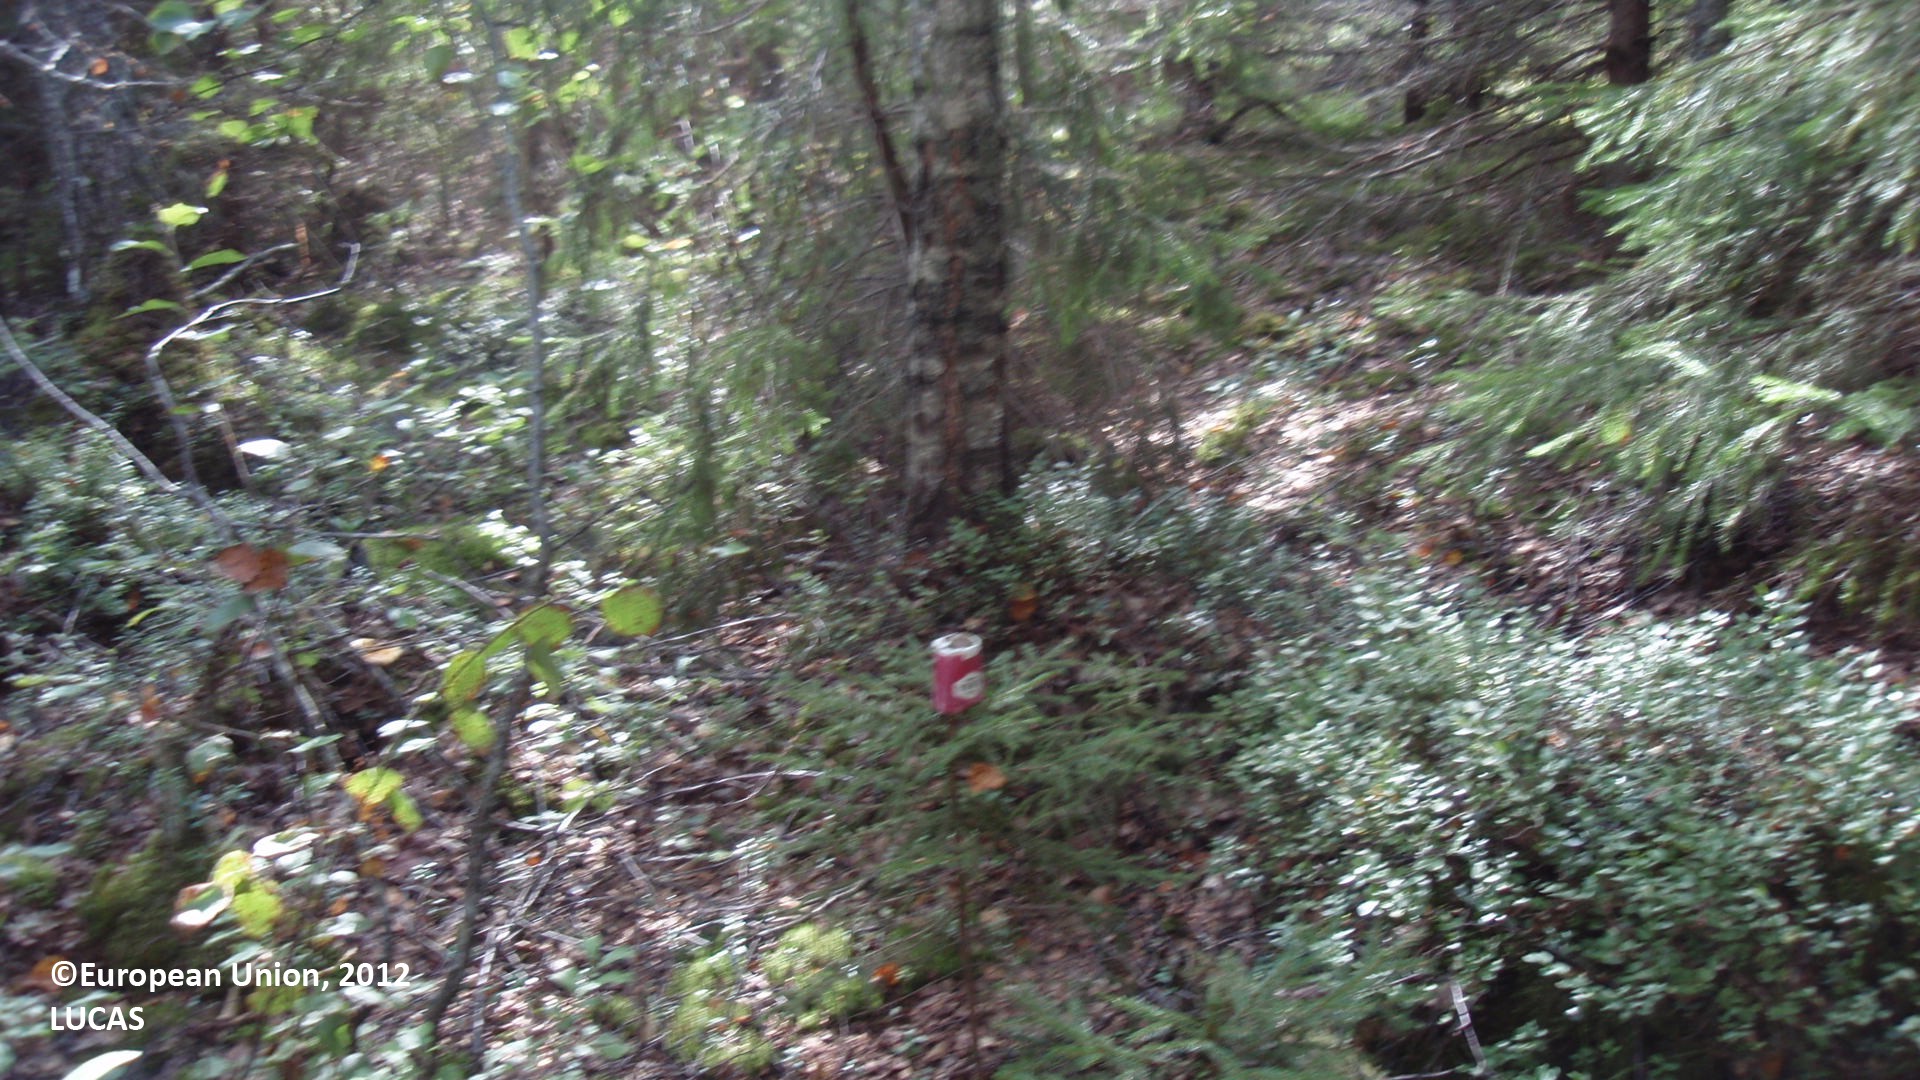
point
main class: Woodland
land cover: Spruce dominated mixed woodland
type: boreal forest
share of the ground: 50 - 75 %
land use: Forestry
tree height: > 5 m
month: August
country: FI
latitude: 60.8073
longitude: 27.2507
